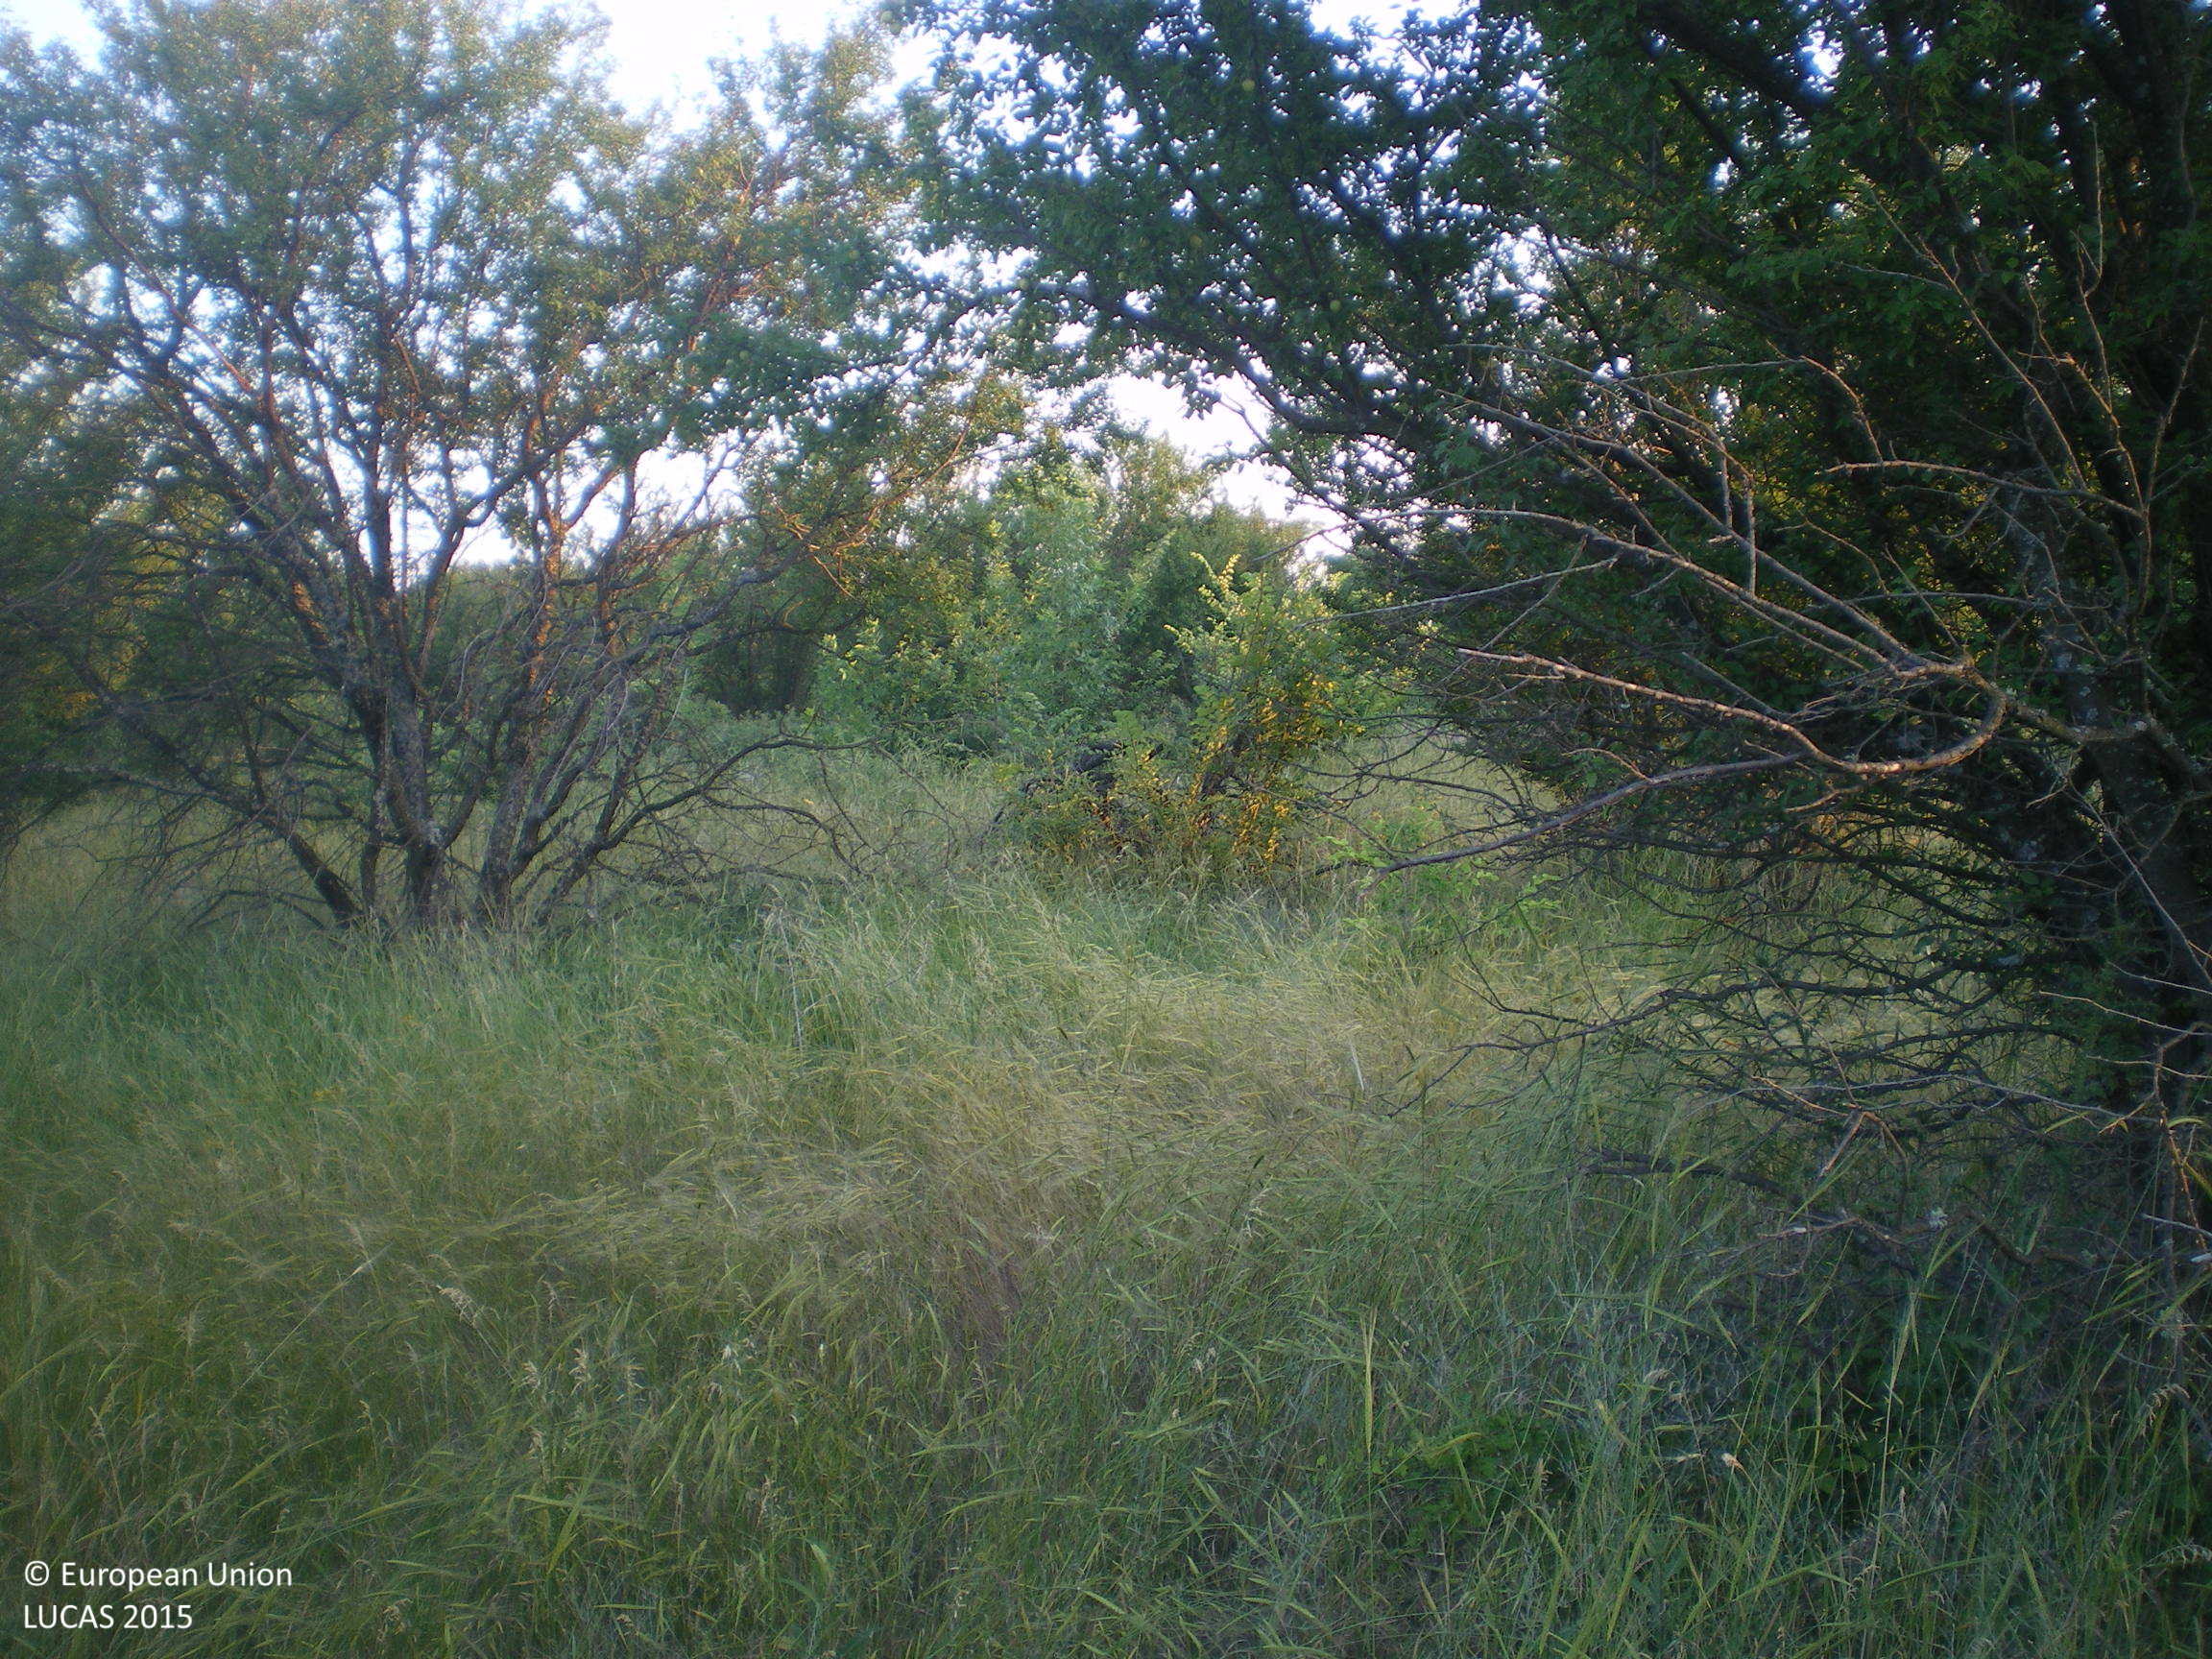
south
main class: Woodland
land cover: Broadleaved woodland
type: mesophytic deciduous forest
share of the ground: 25 - 50 %
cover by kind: broadleaved forest trees 50 %, herbaceous plants 35 %, shrubs 15 %
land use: Semi-natural and natural areas not in use
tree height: > 5 m
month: June
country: BG
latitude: 42.3857
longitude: 25.1600
